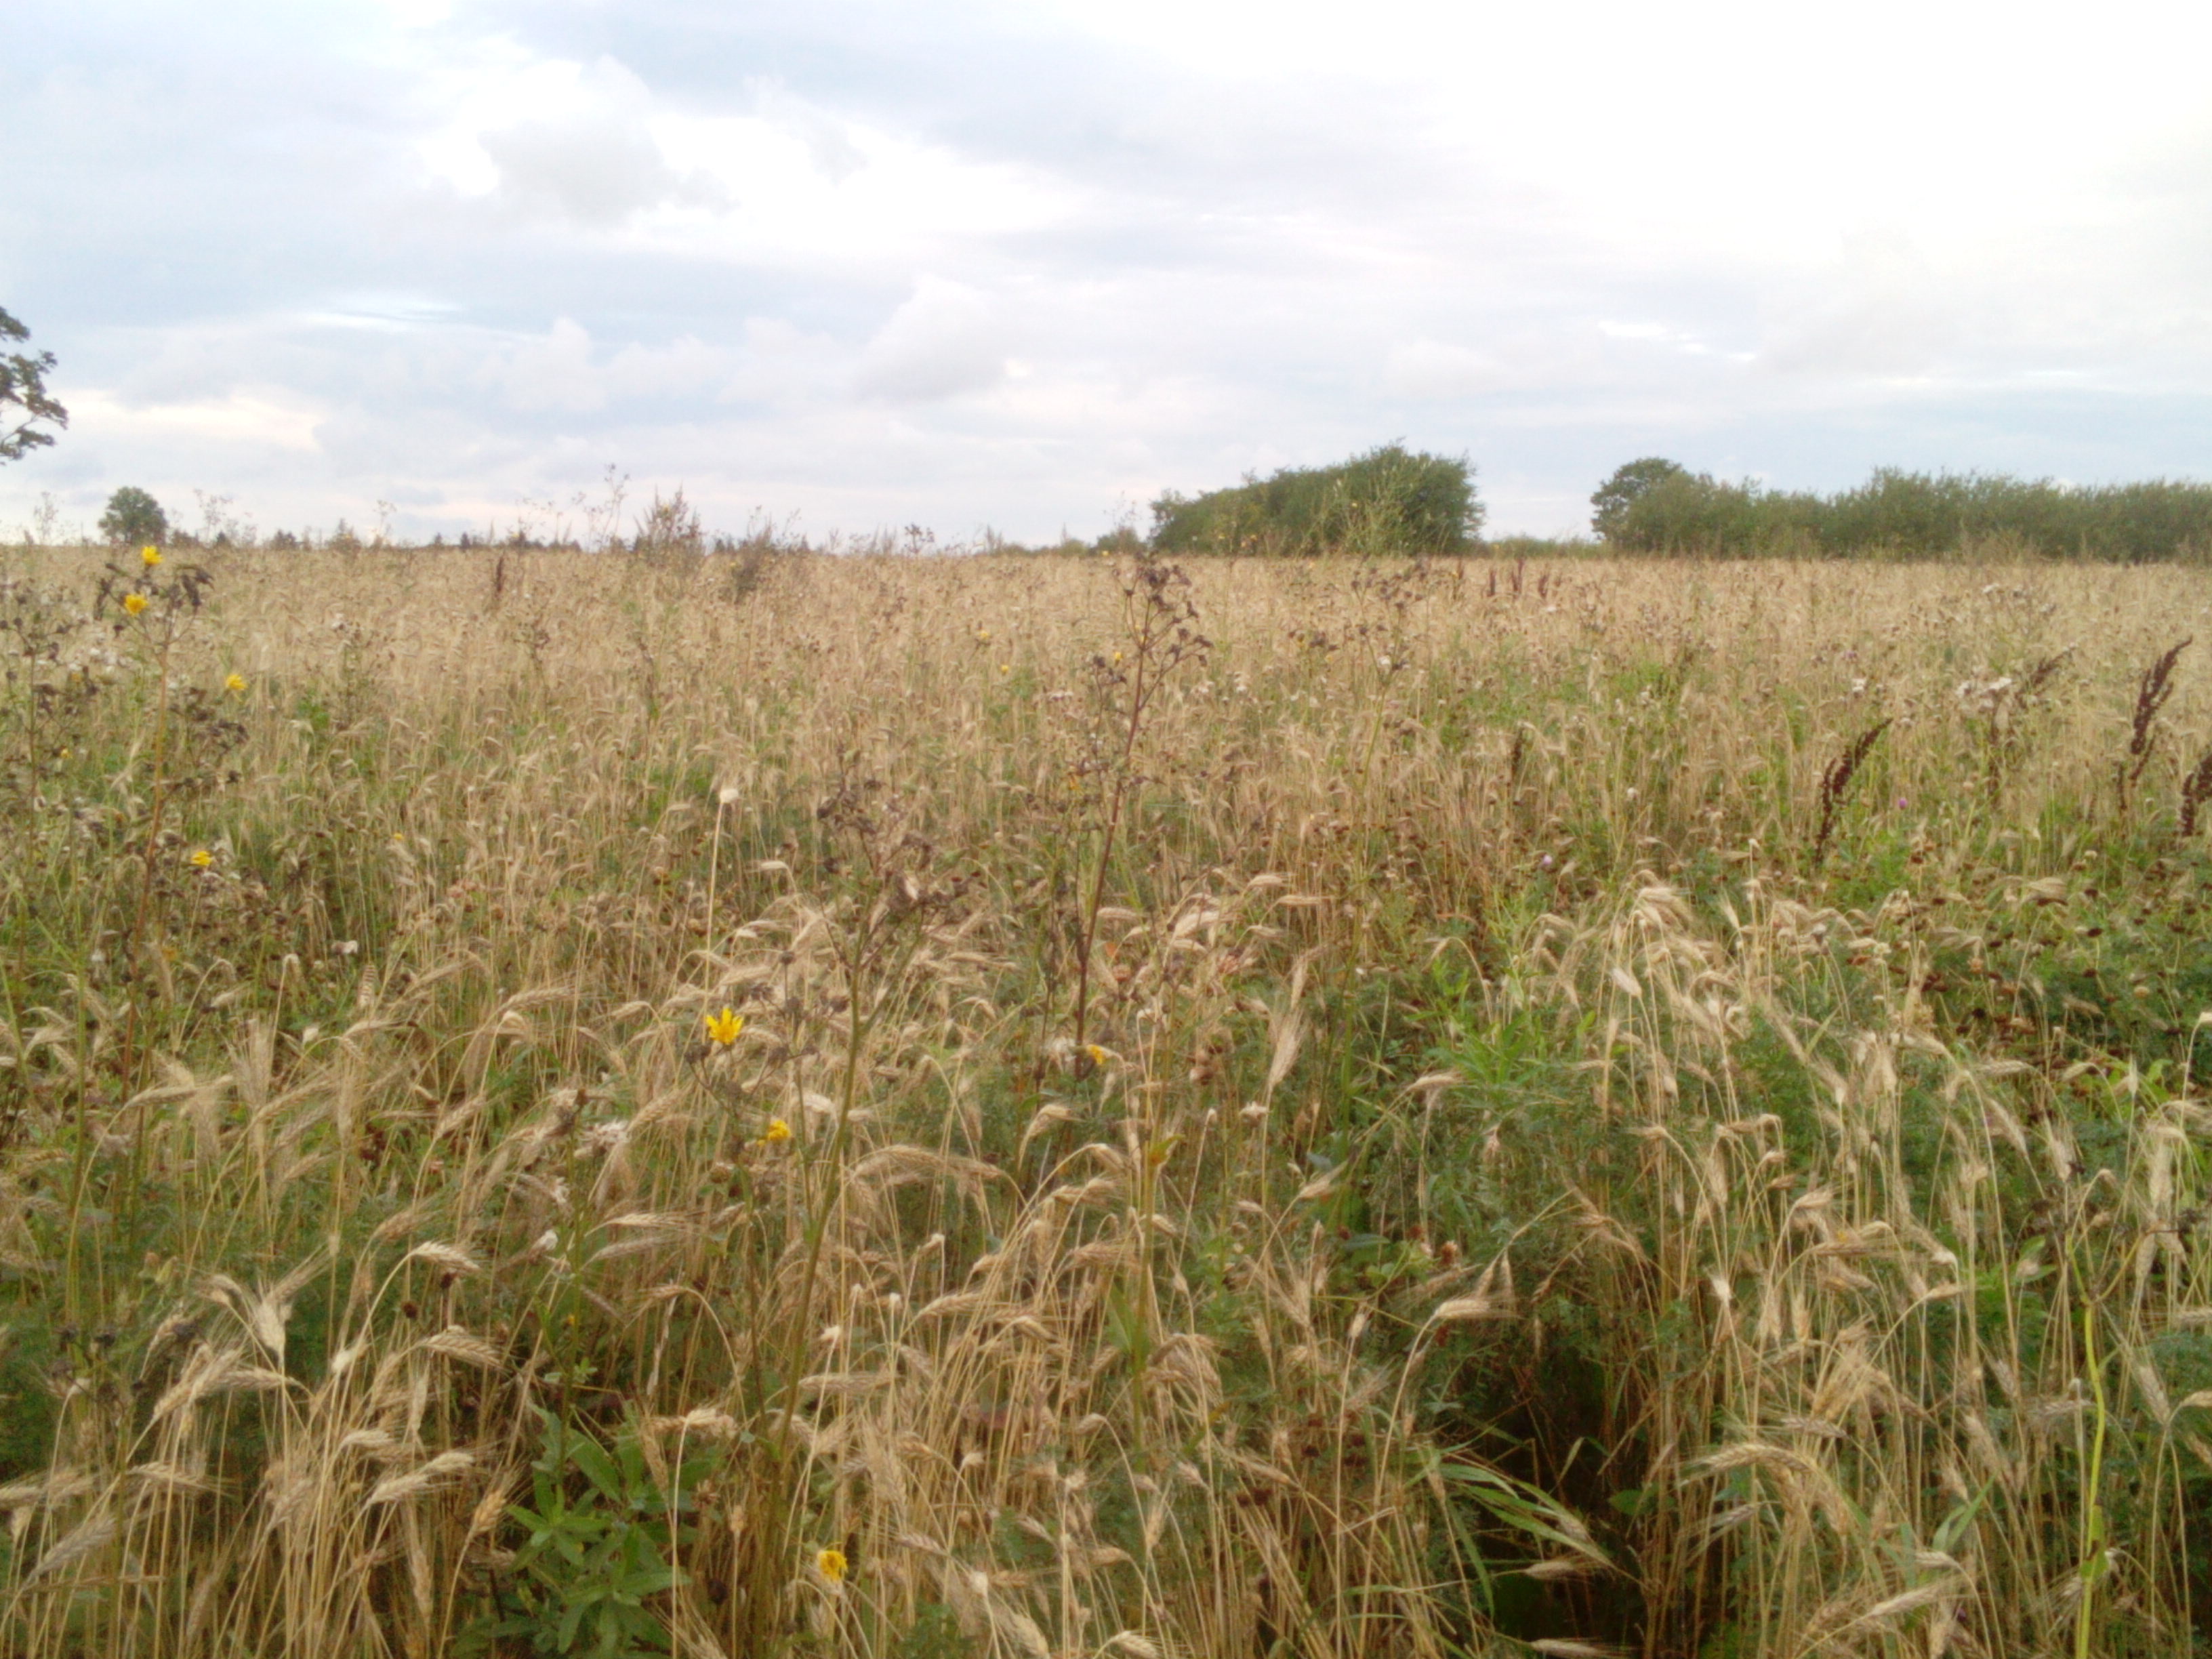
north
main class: Cropland
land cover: Barley
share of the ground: > 75 %
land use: Agriculture (excluding fallow land and kitchen gardens)
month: September
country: LT
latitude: 55.9287
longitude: 22.5931
